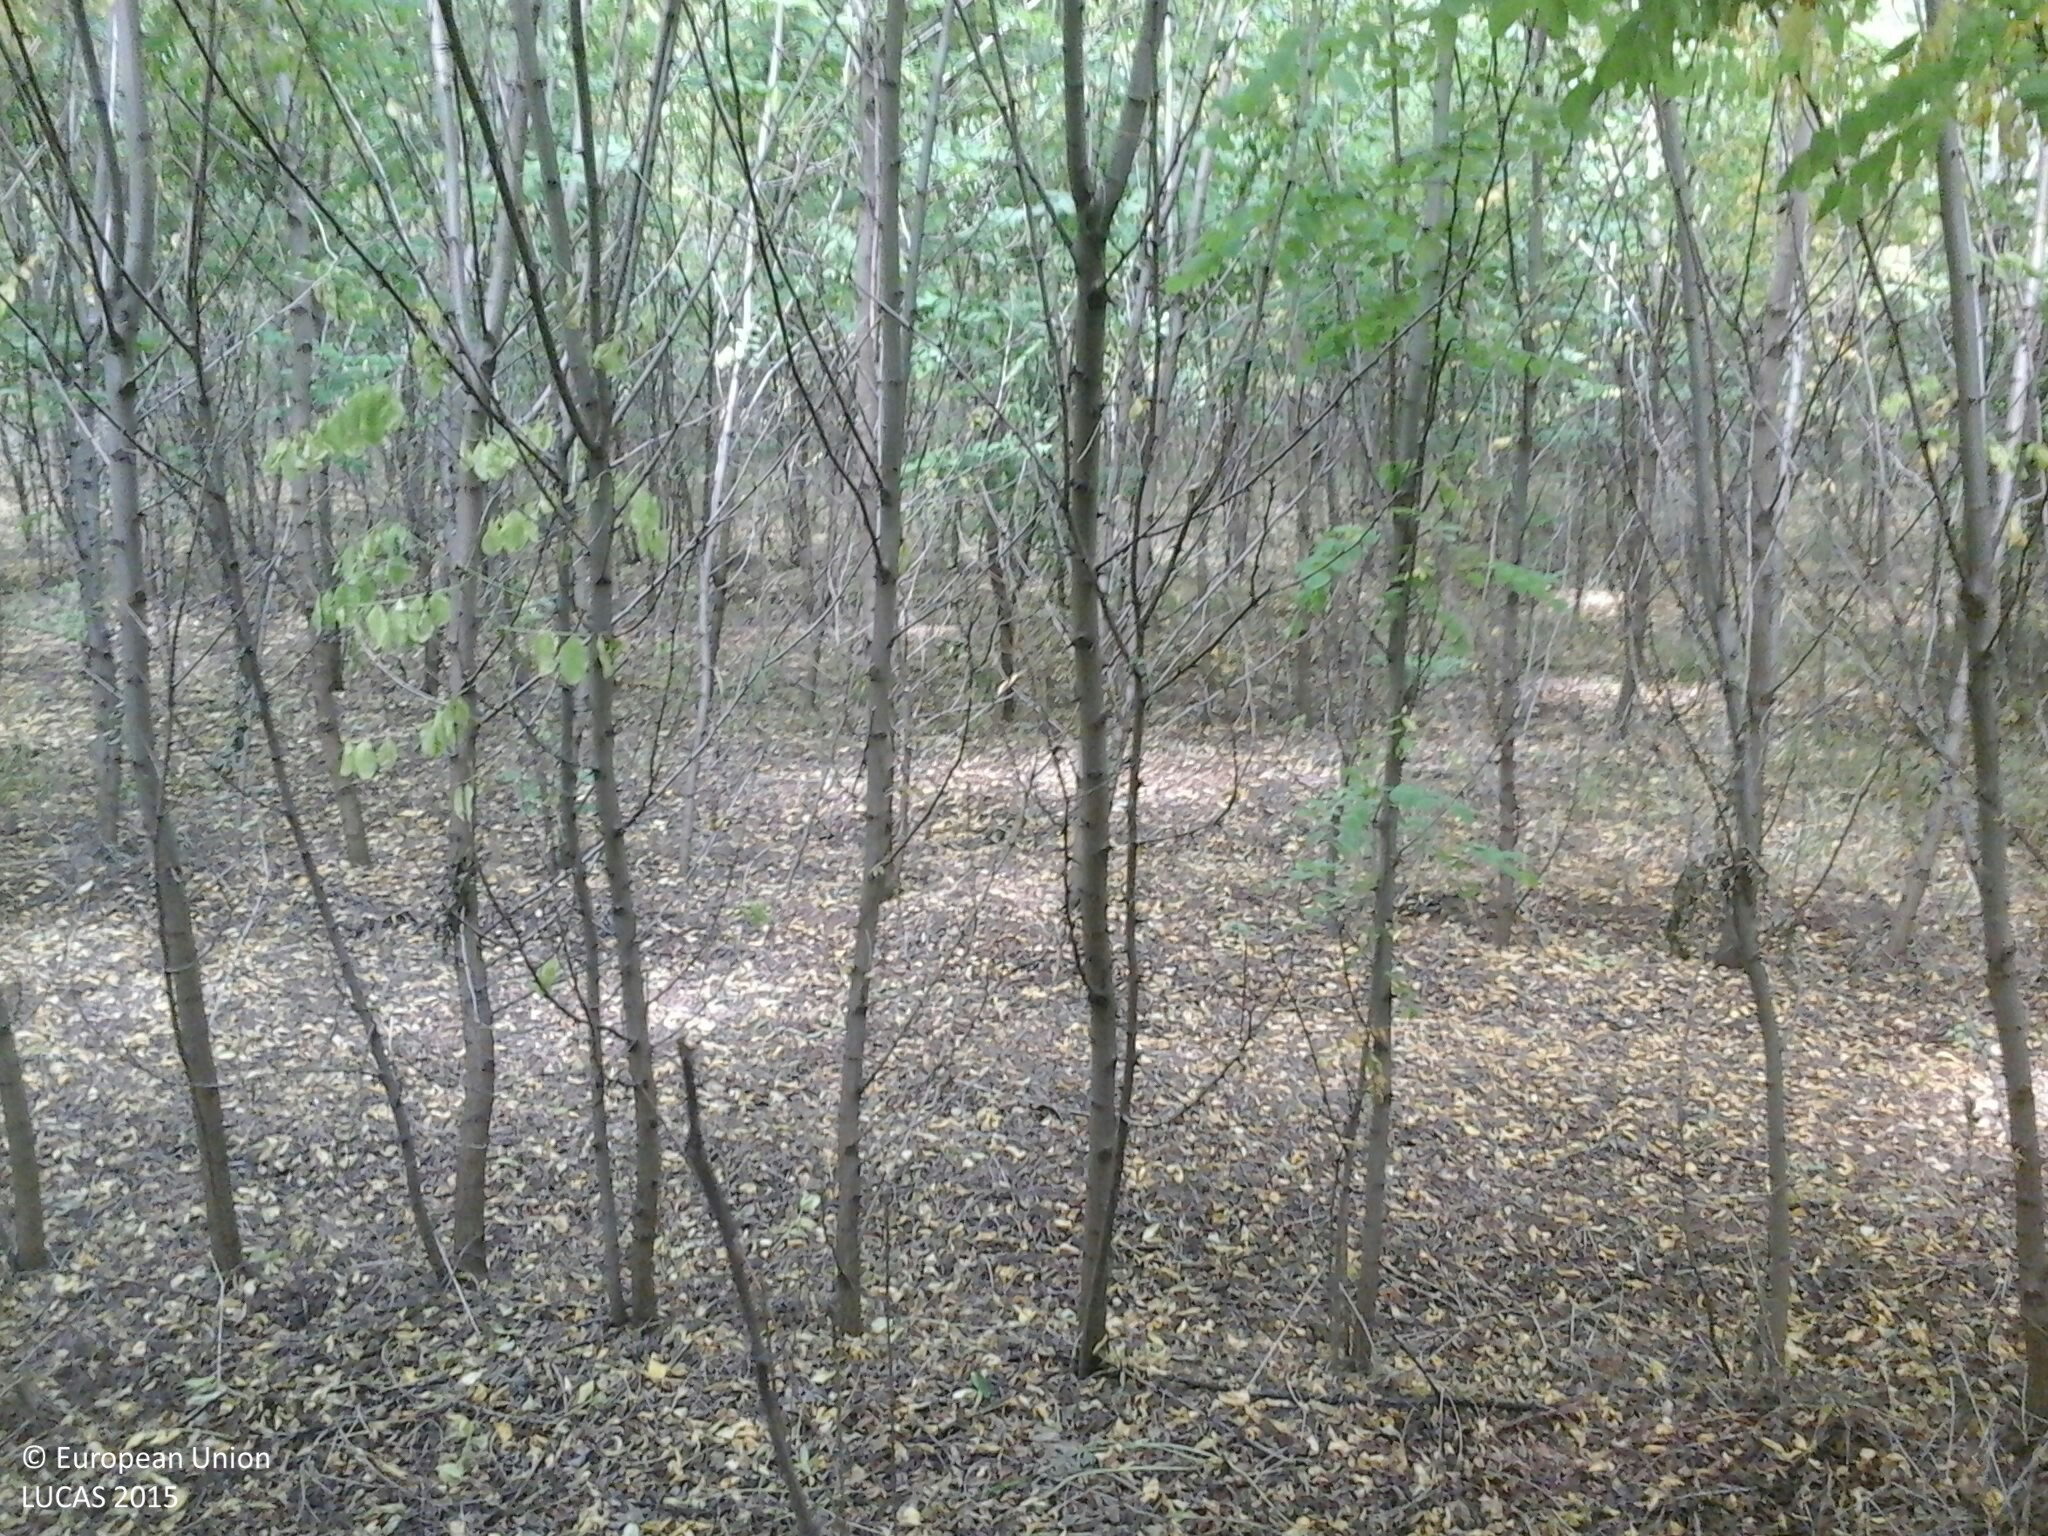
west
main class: Cropland
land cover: Nurseries
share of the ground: > 75 %
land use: Forestry
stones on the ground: < 10 %
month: June
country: HU
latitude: 47.4054
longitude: 19.3890
